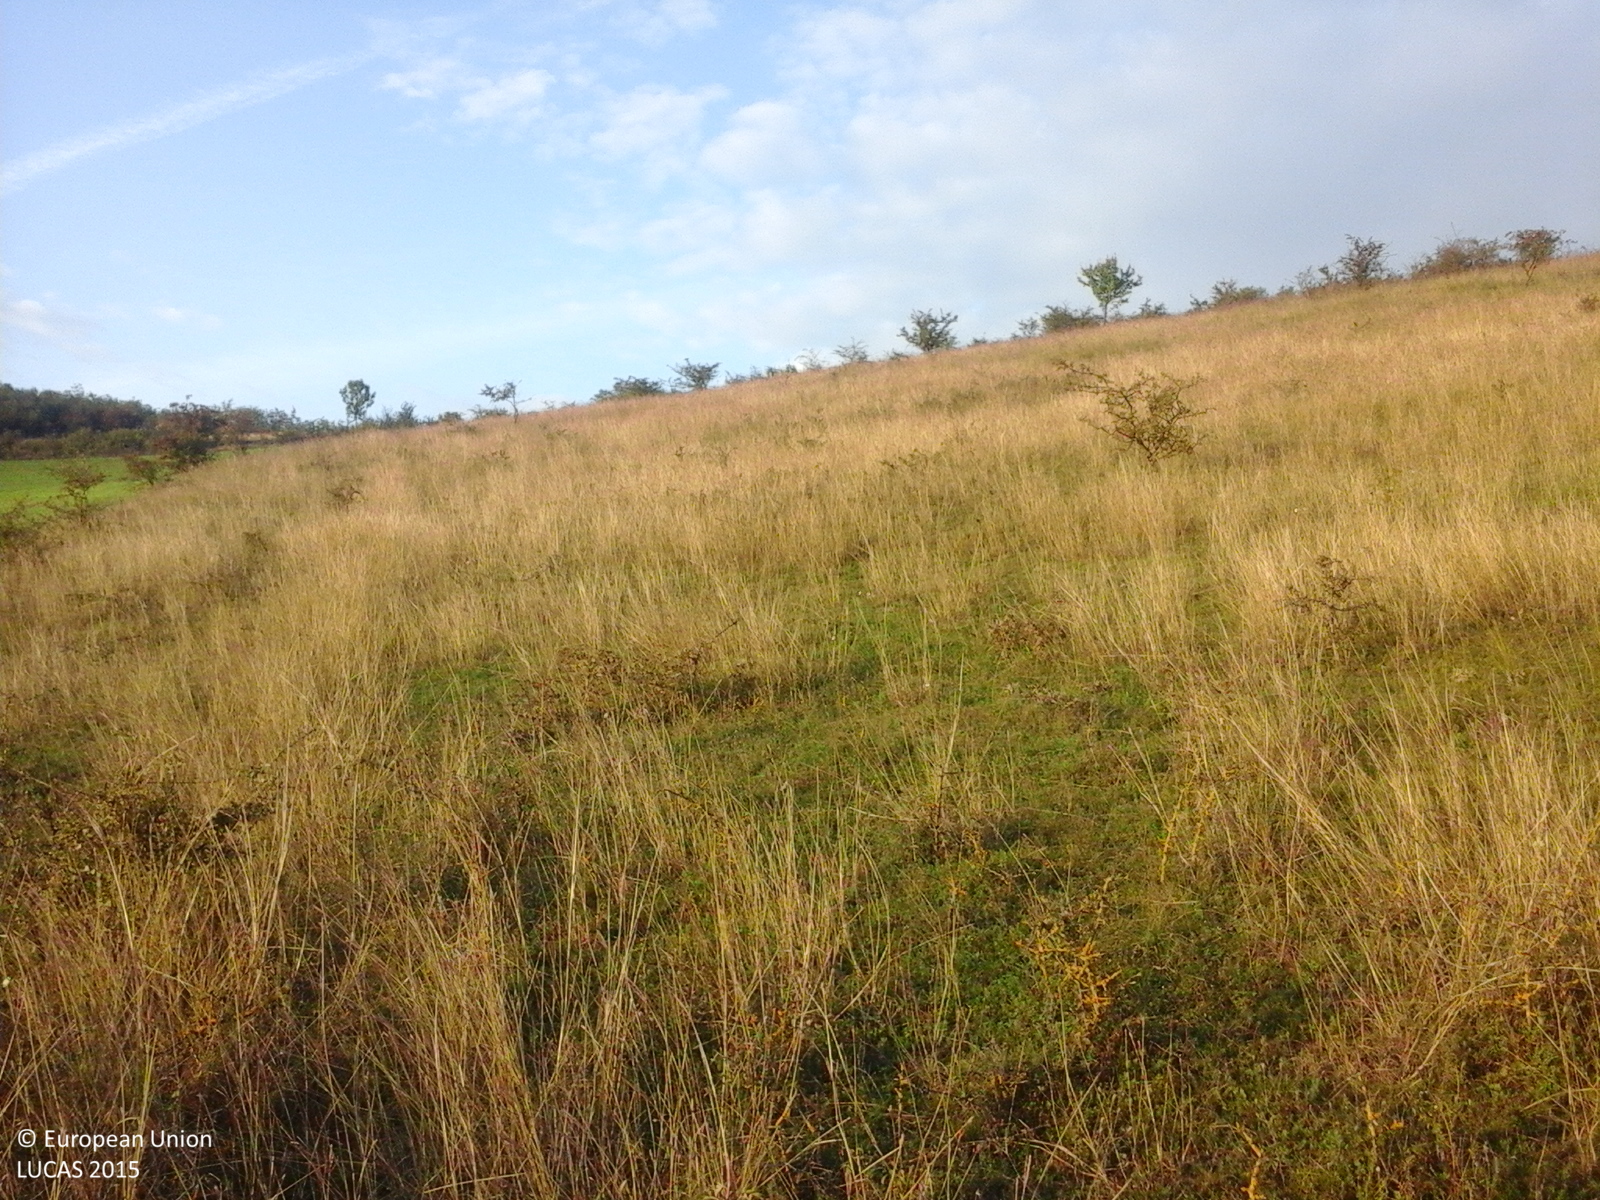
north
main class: Grassland
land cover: Spontaneously vegetated surfaces
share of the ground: > 75 %
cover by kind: herbaceous plants 100 %
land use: Agriculture (excluding fallow land and kitchen gardens)
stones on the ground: < 10 %
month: October
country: RO
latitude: 46.4892
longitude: 24.3755
